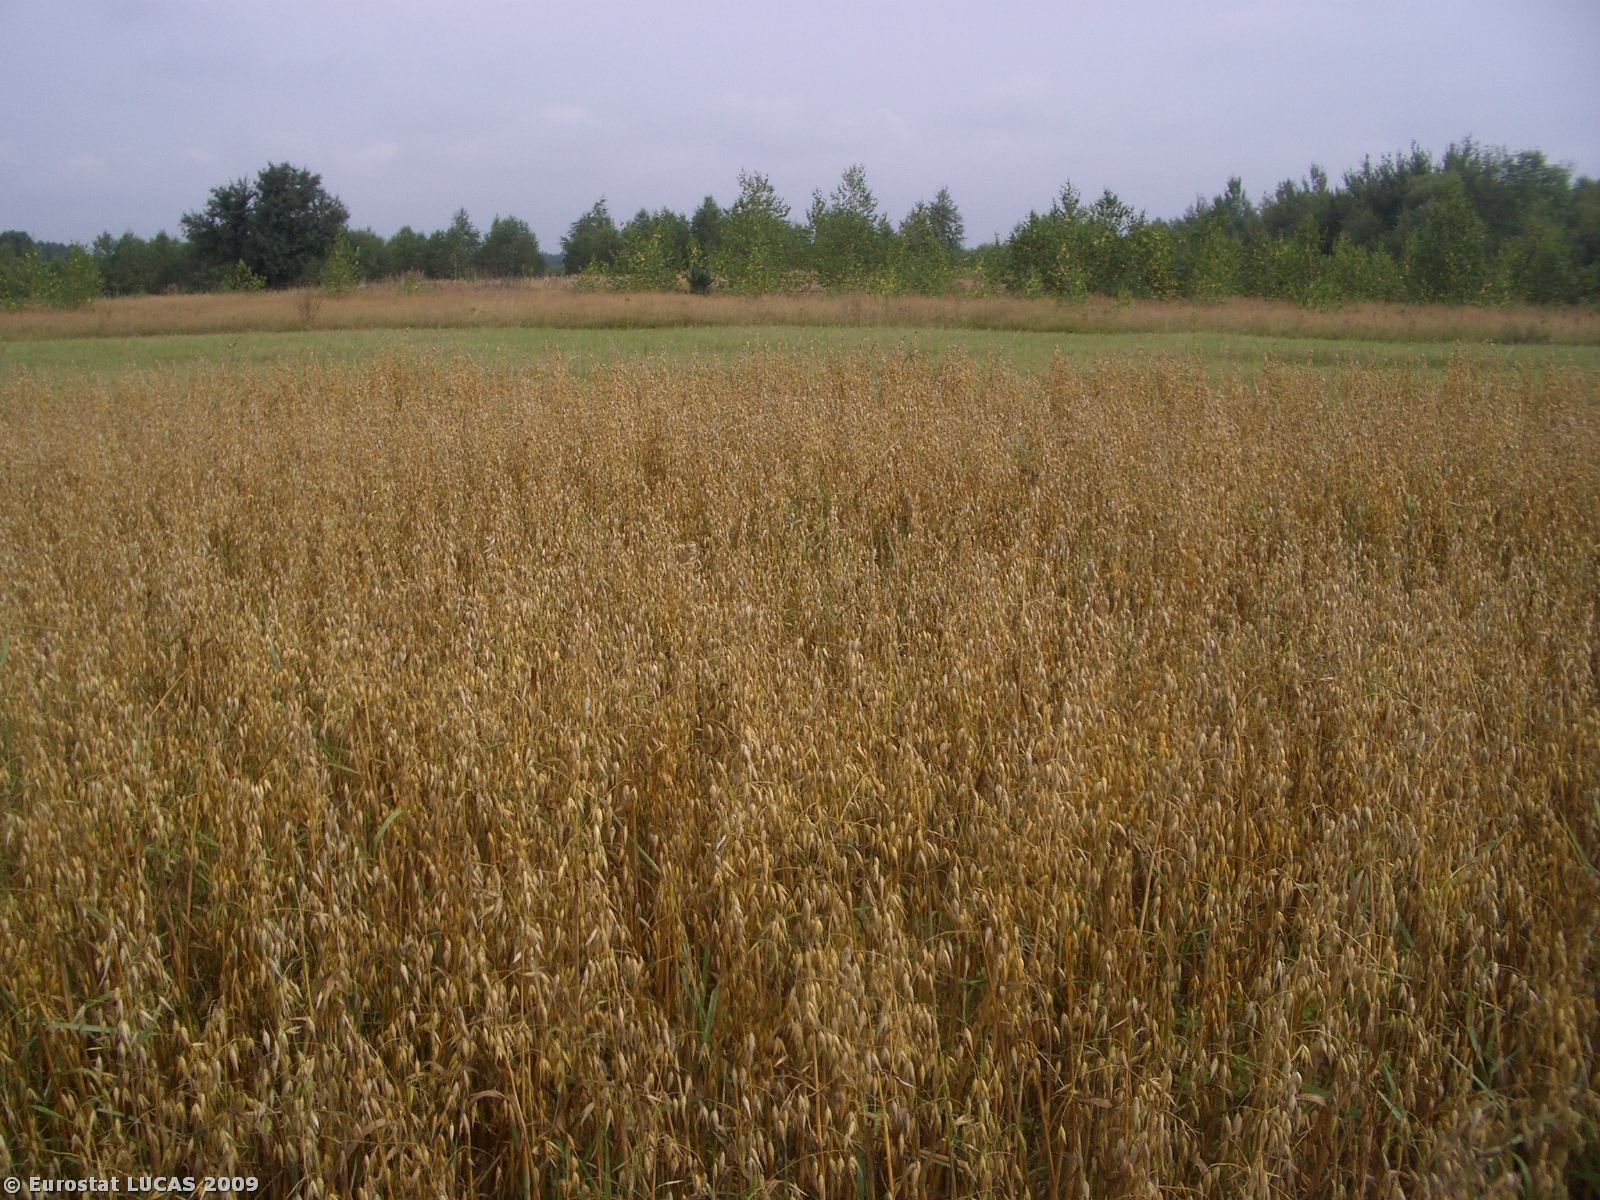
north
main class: Cropland
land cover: Oats
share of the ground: 50 - 75 %
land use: Agriculture (excluding fallow land and kitchen gardens)
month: August
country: PL
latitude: 51.9939
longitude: 23.2602
